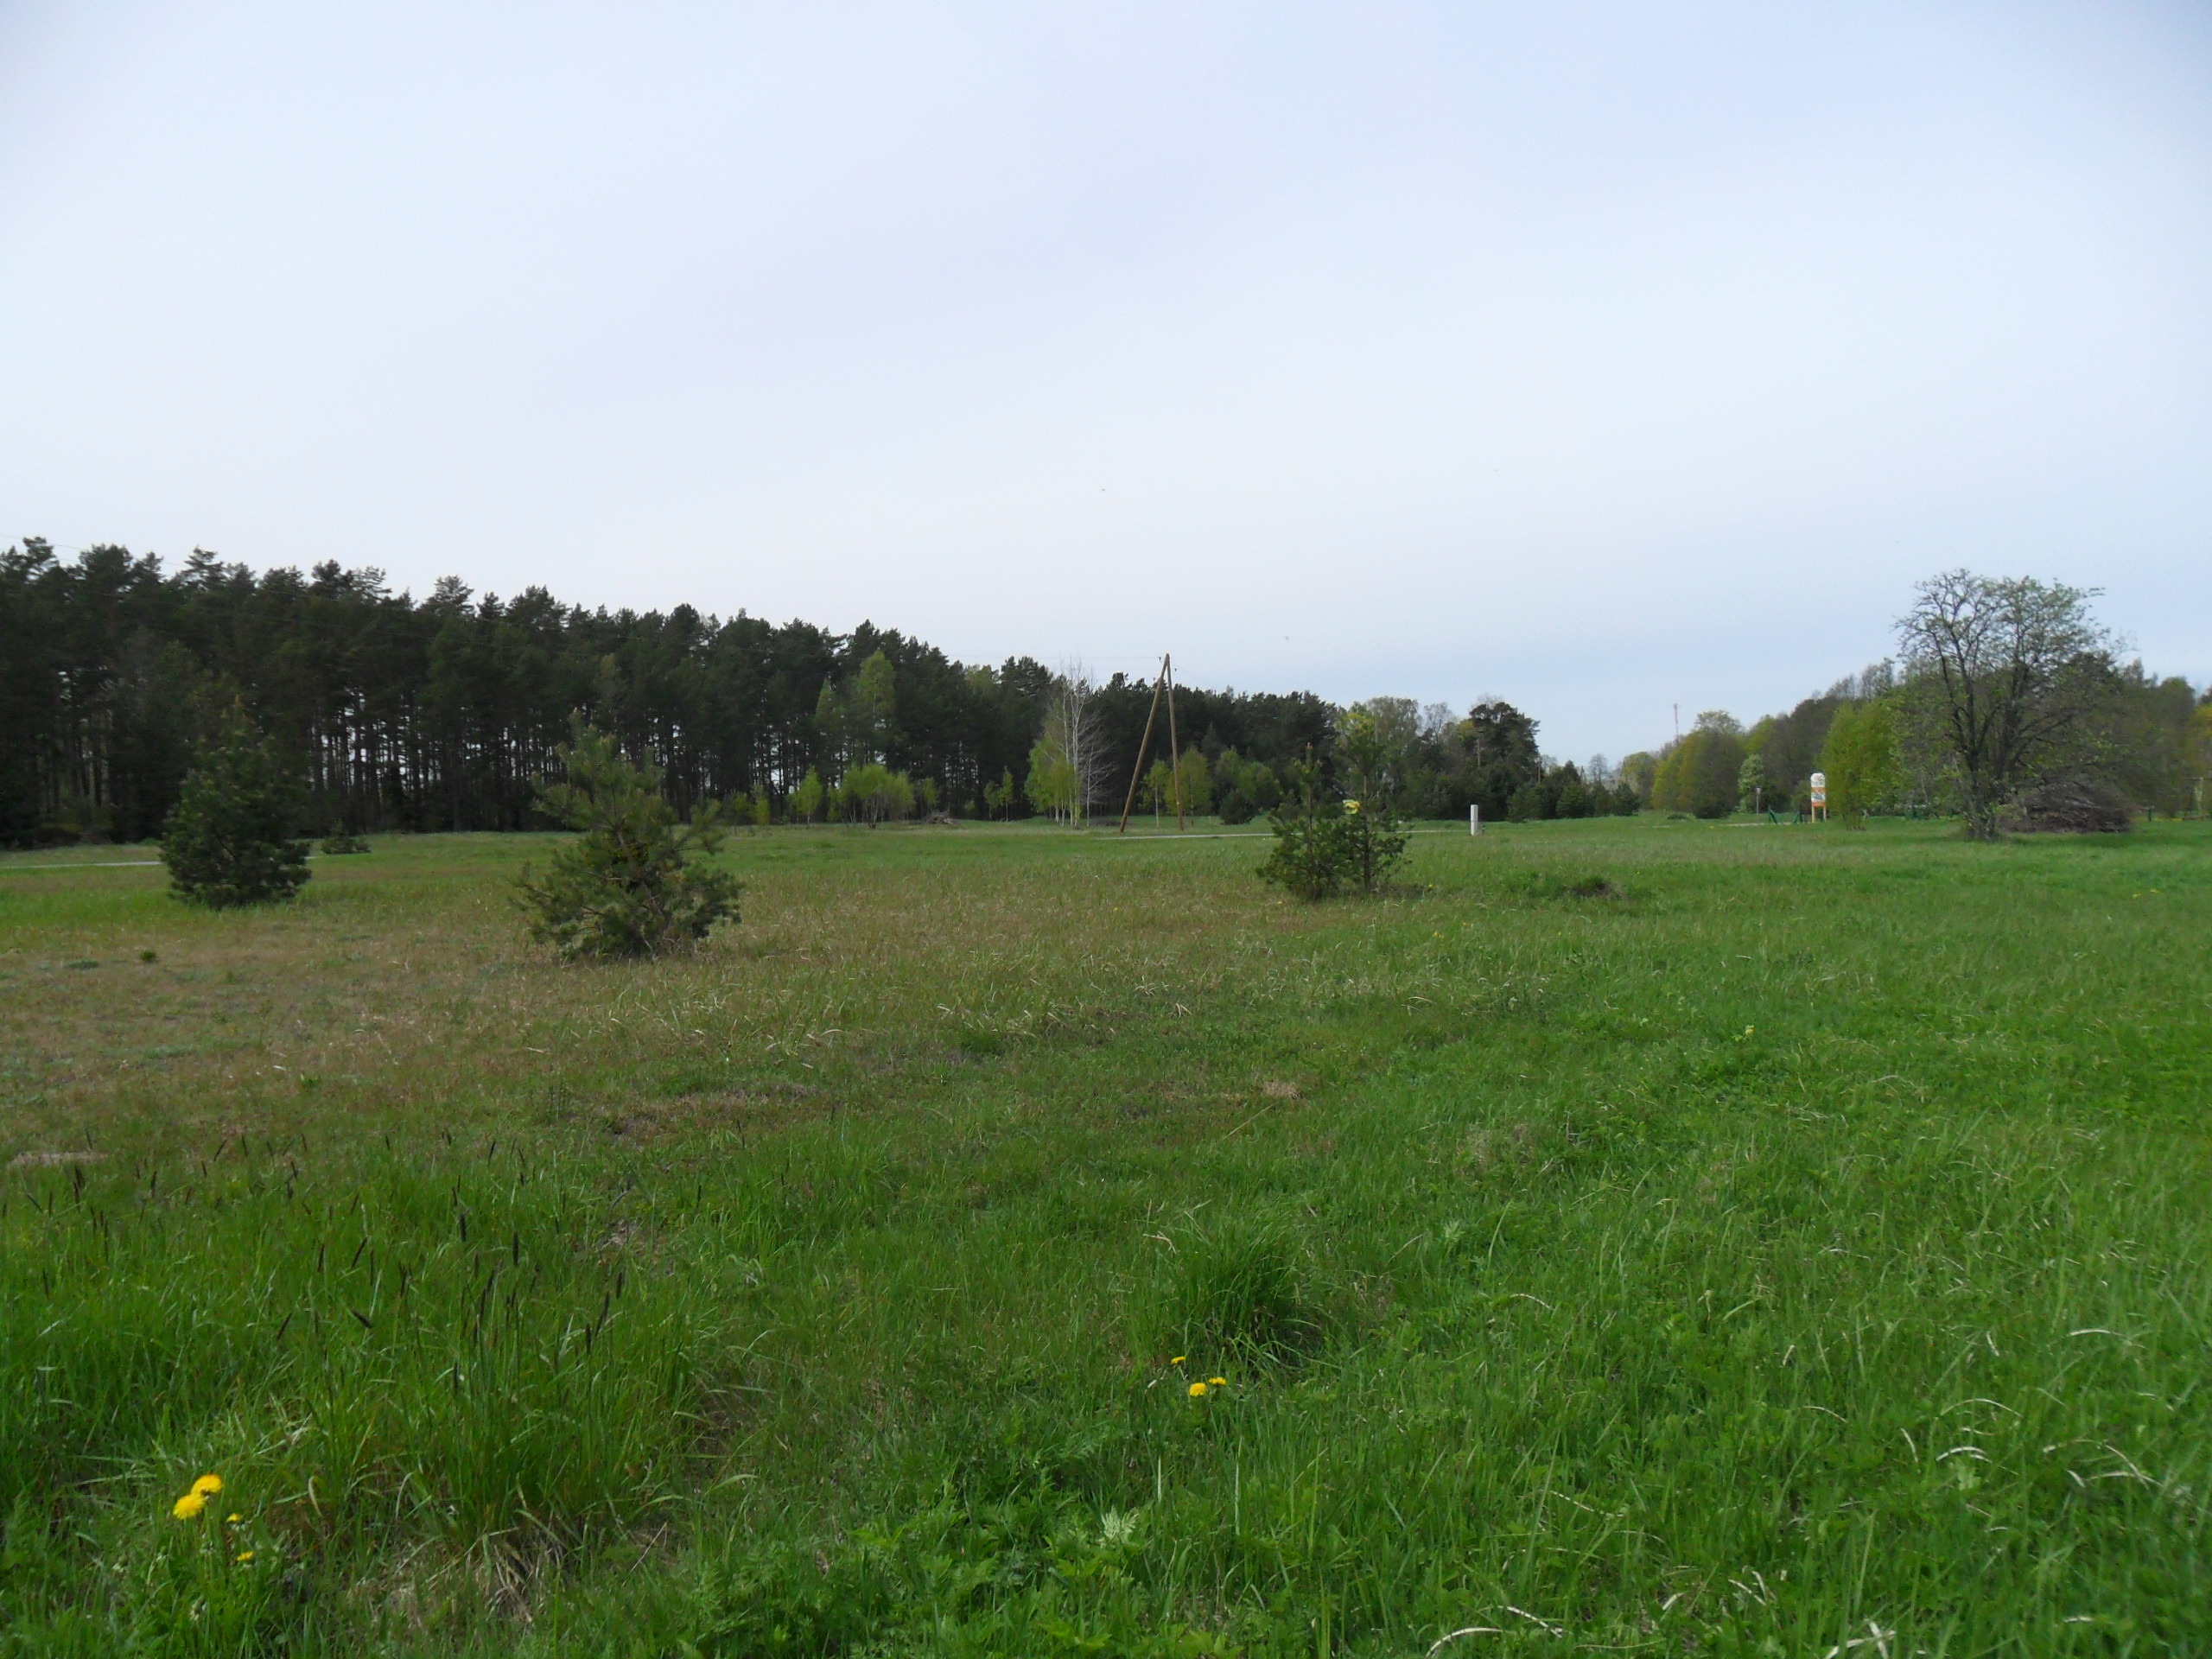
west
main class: Grassland
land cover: Grassland without tree/shrub cover
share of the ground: > 75 %
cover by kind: herbaceous plants 100 %
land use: Agriculture (excluding fallow land and kitchen gardens)
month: May
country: LV
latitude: 57.3818
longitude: 23.0196
